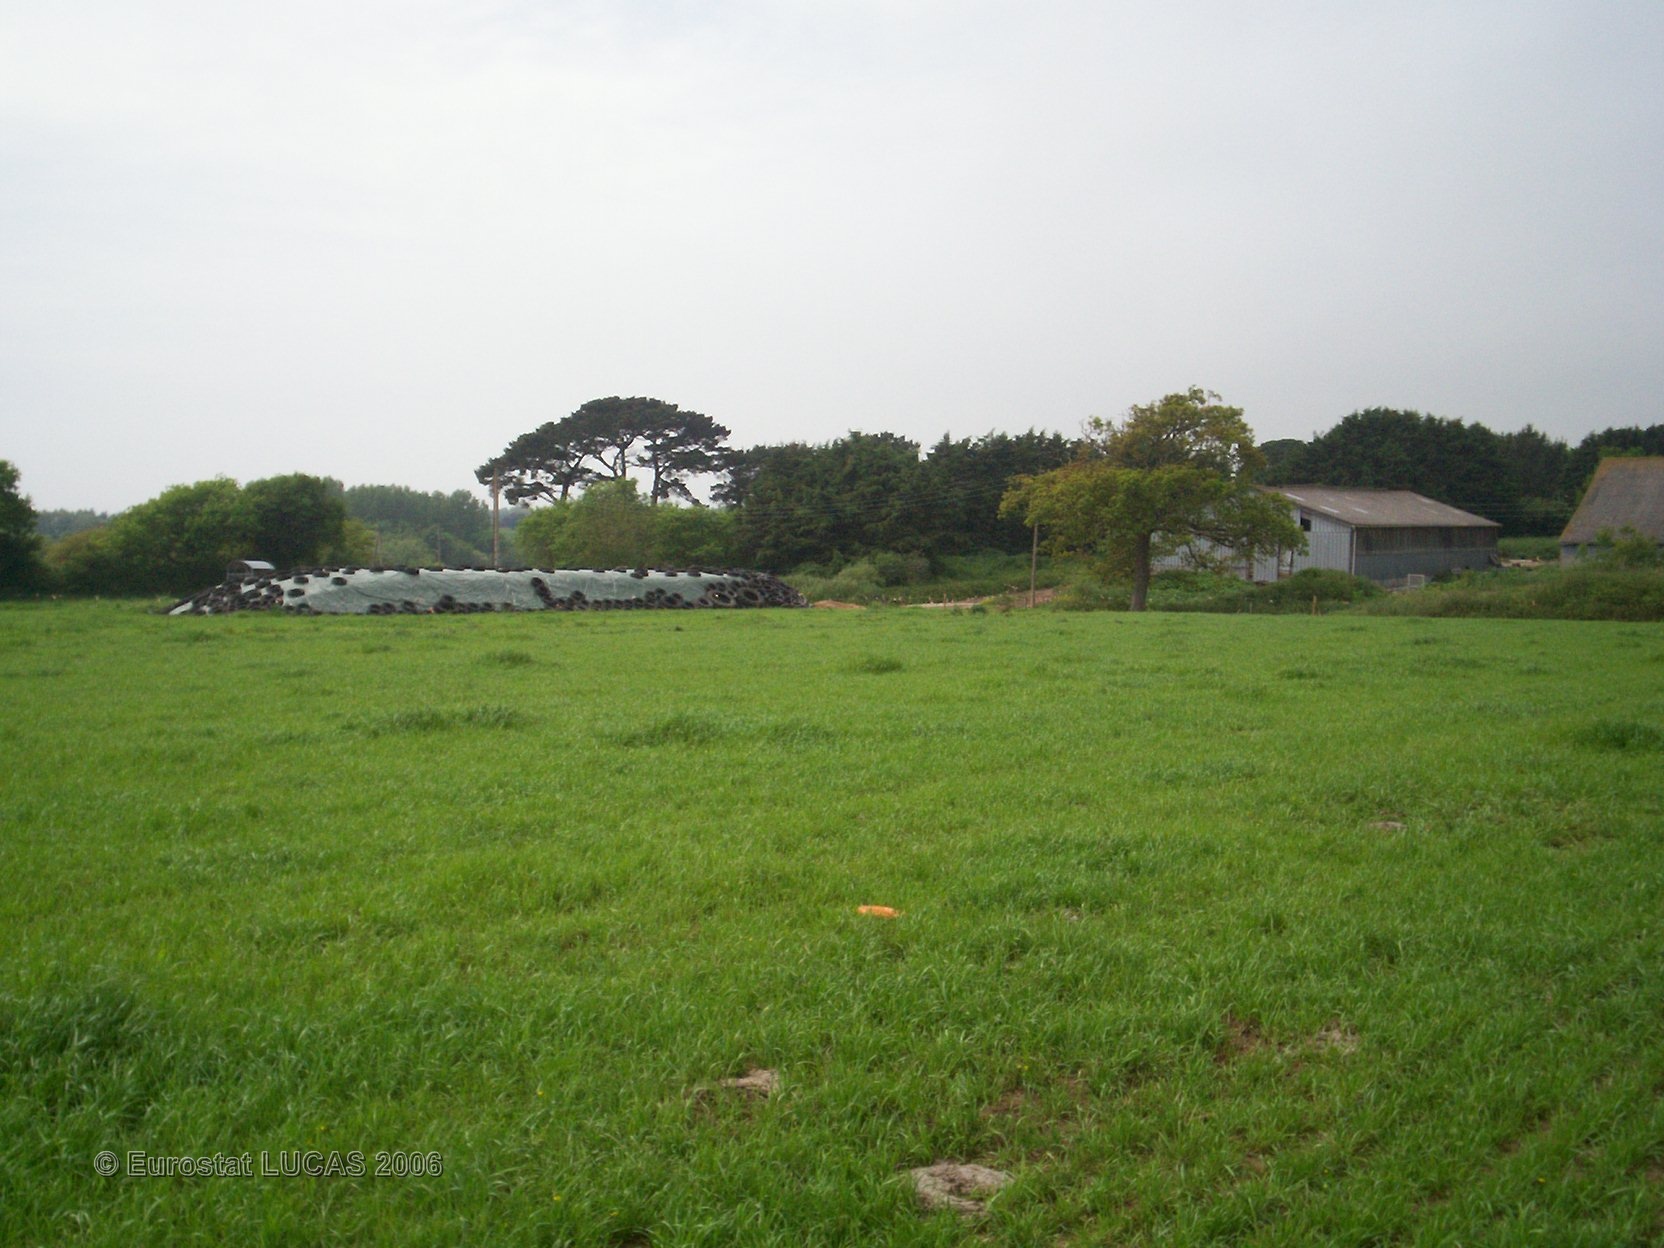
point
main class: Grassland
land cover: Grassland without tree/shrub cover
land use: Agriculture (excluding fallow land and kitchen gardens)
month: May
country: FR
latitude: 47.8184
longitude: -3.8522
